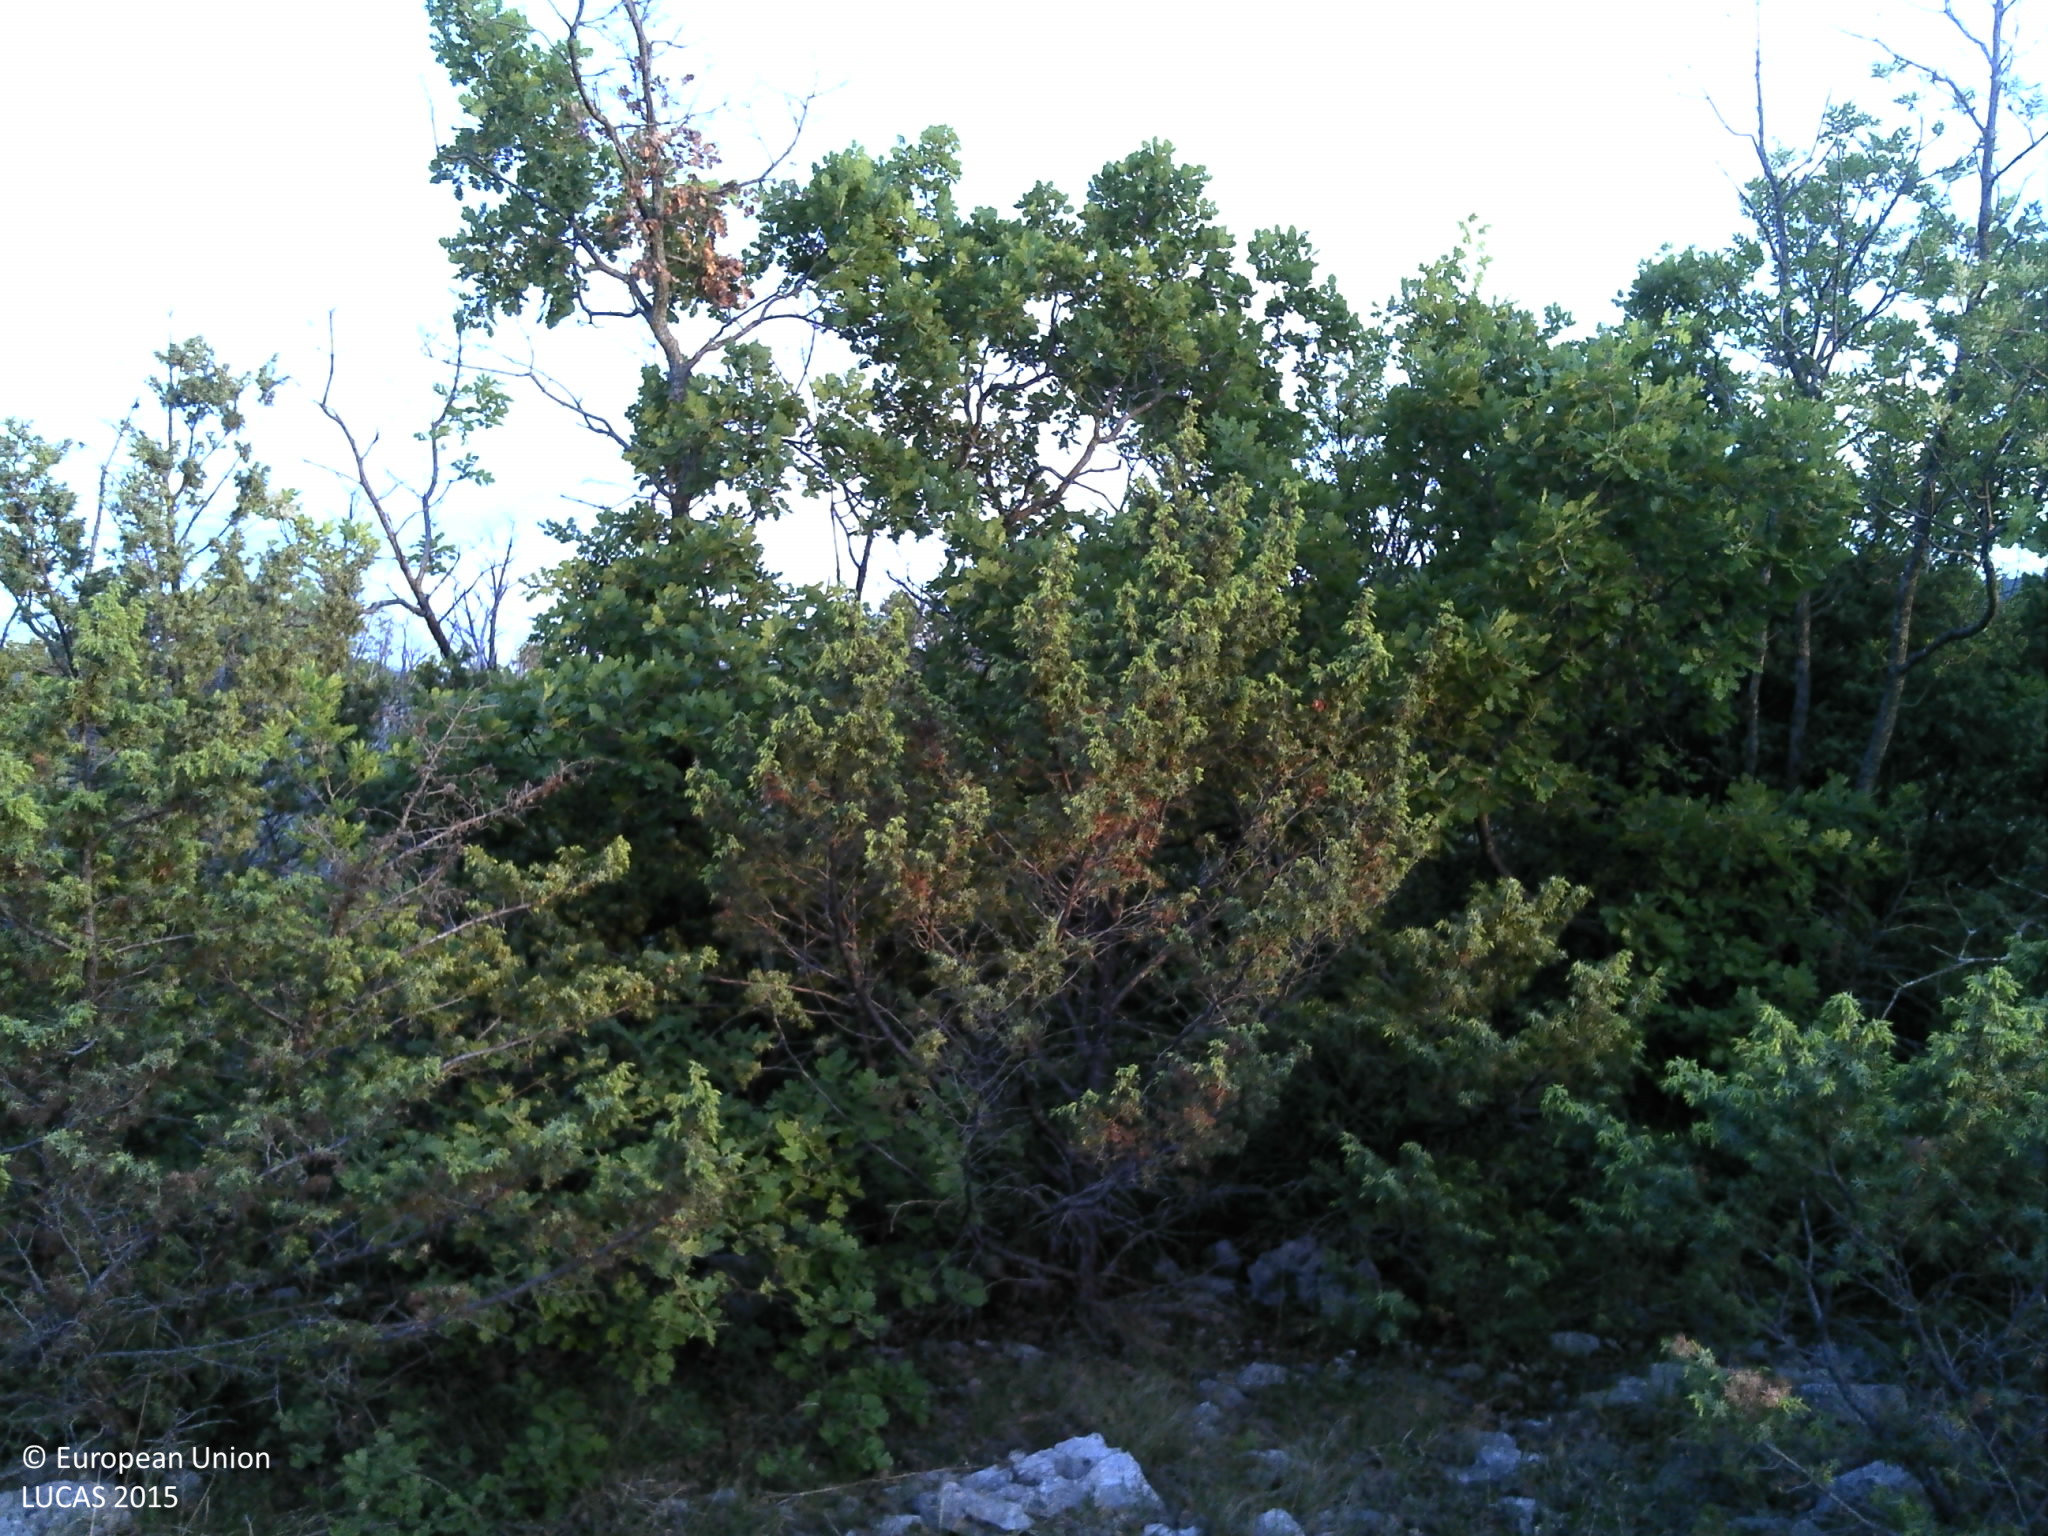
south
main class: Shrubland
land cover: Shrubland without tree cover
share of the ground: 25 - 50 %
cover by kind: herbaceous plants 45 %, shrubs 25 %, unconsolidated bare surface 20 %, consolidated bare surface 10 %
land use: Semi-natural and natural areas not in use
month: May
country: HR
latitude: 43.7795
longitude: 15.9926
